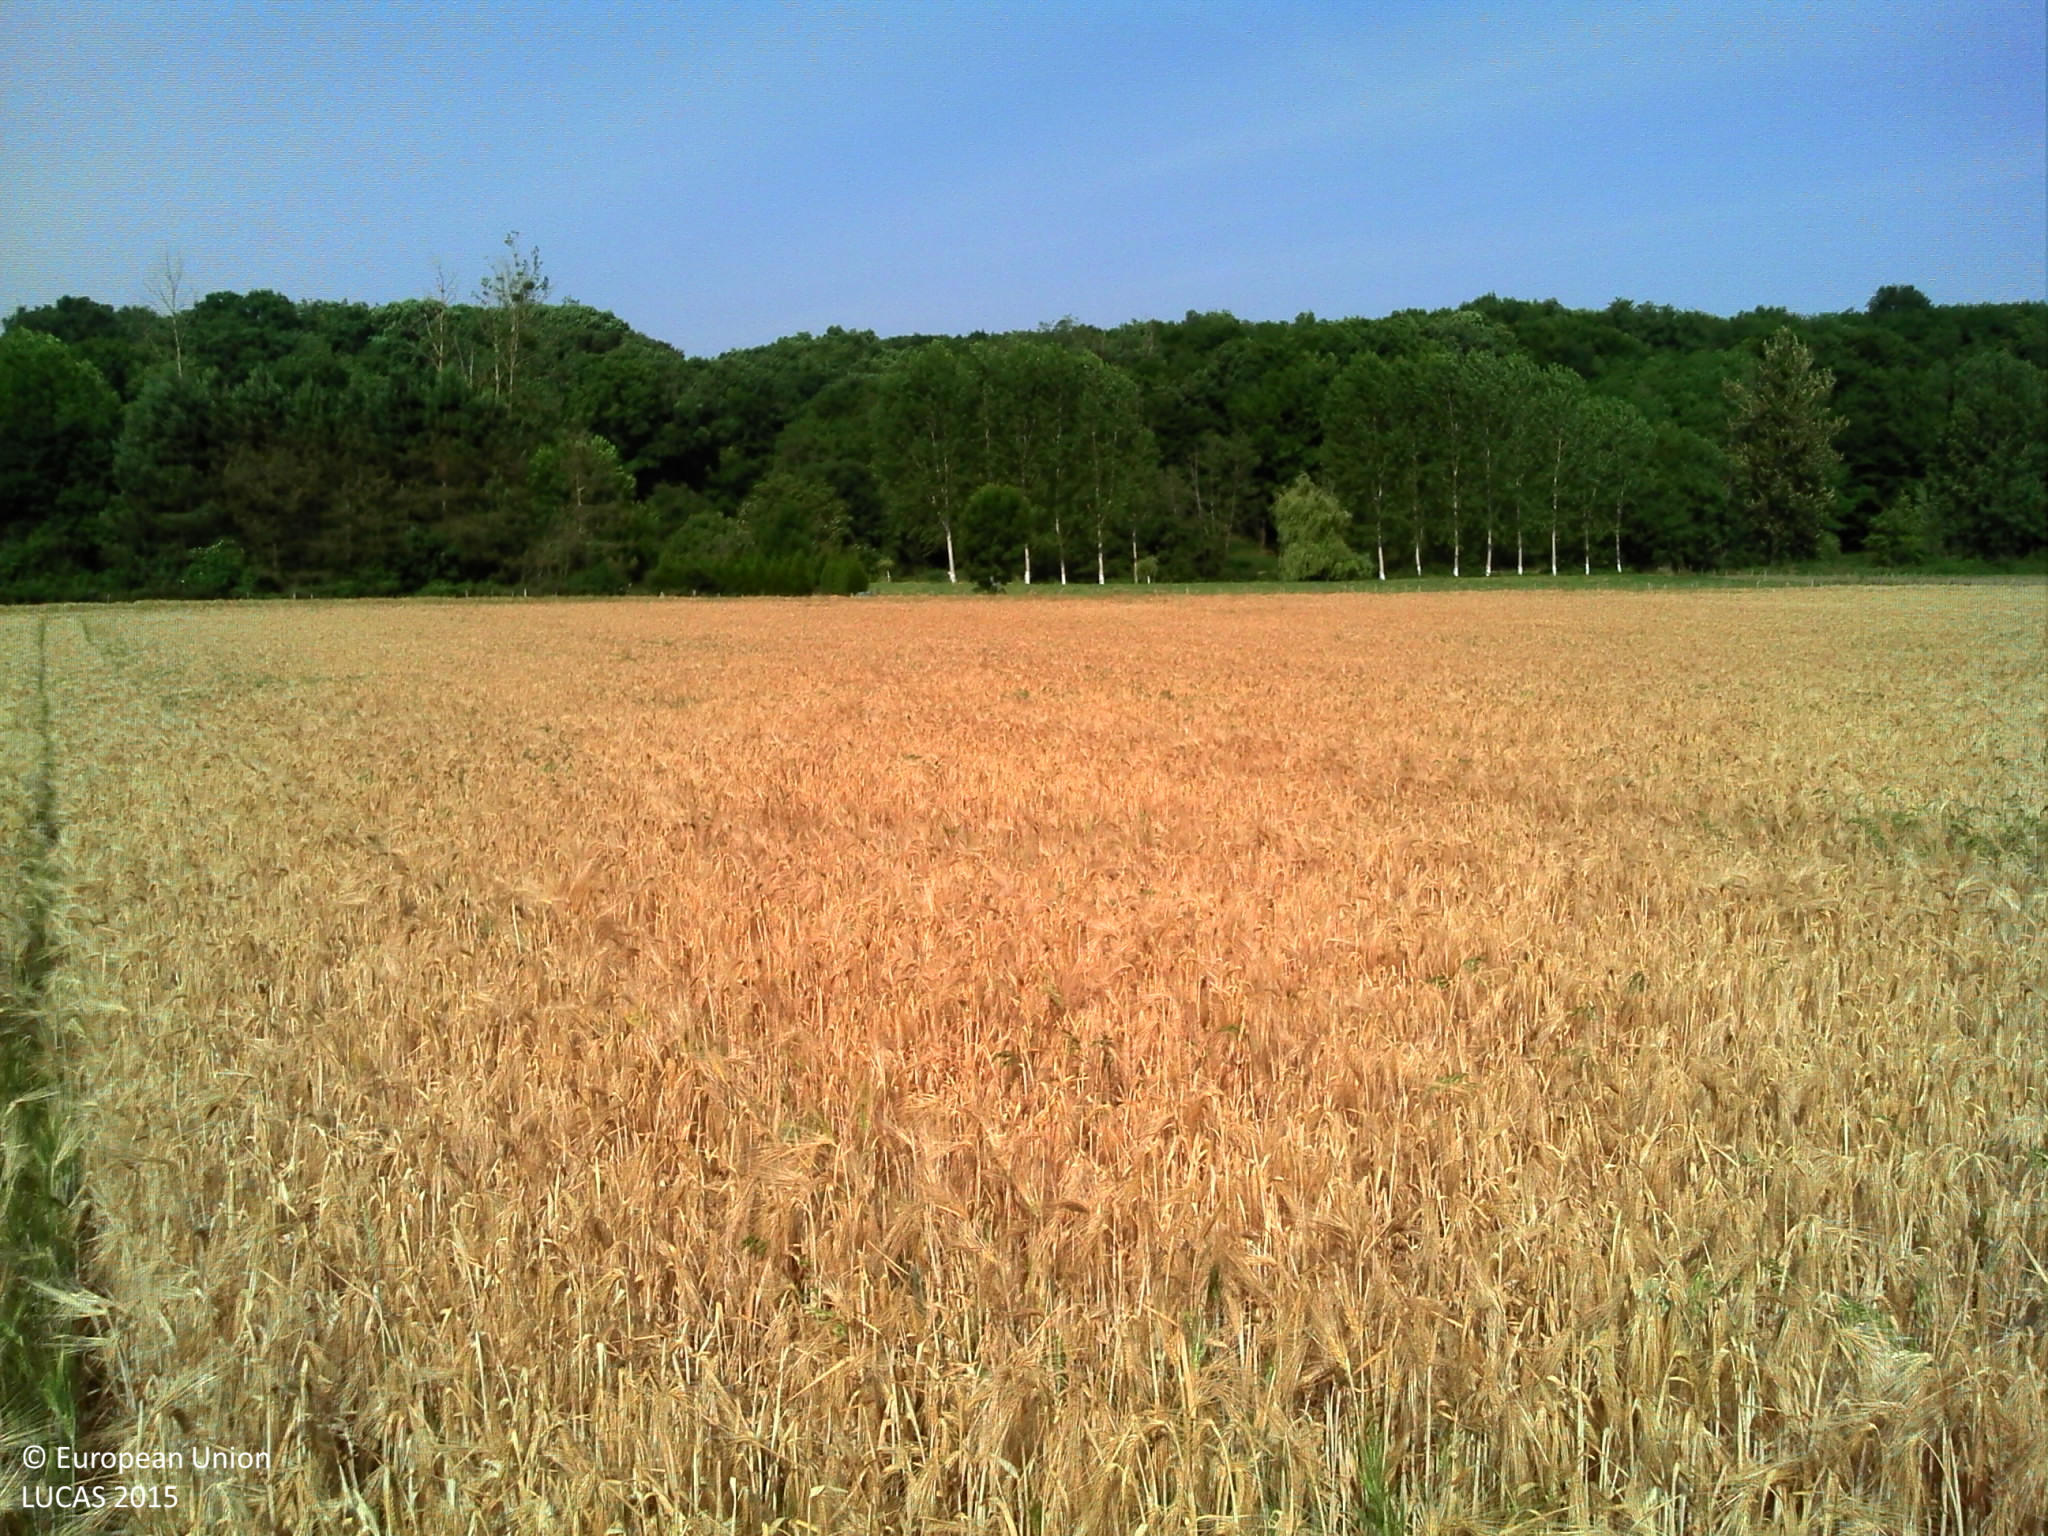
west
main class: Cropland
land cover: Barley
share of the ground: > 75 %
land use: Agriculture (excluding fallow land and kitchen gardens)
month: June
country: FR
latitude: 46.6292
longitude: 0.8550
